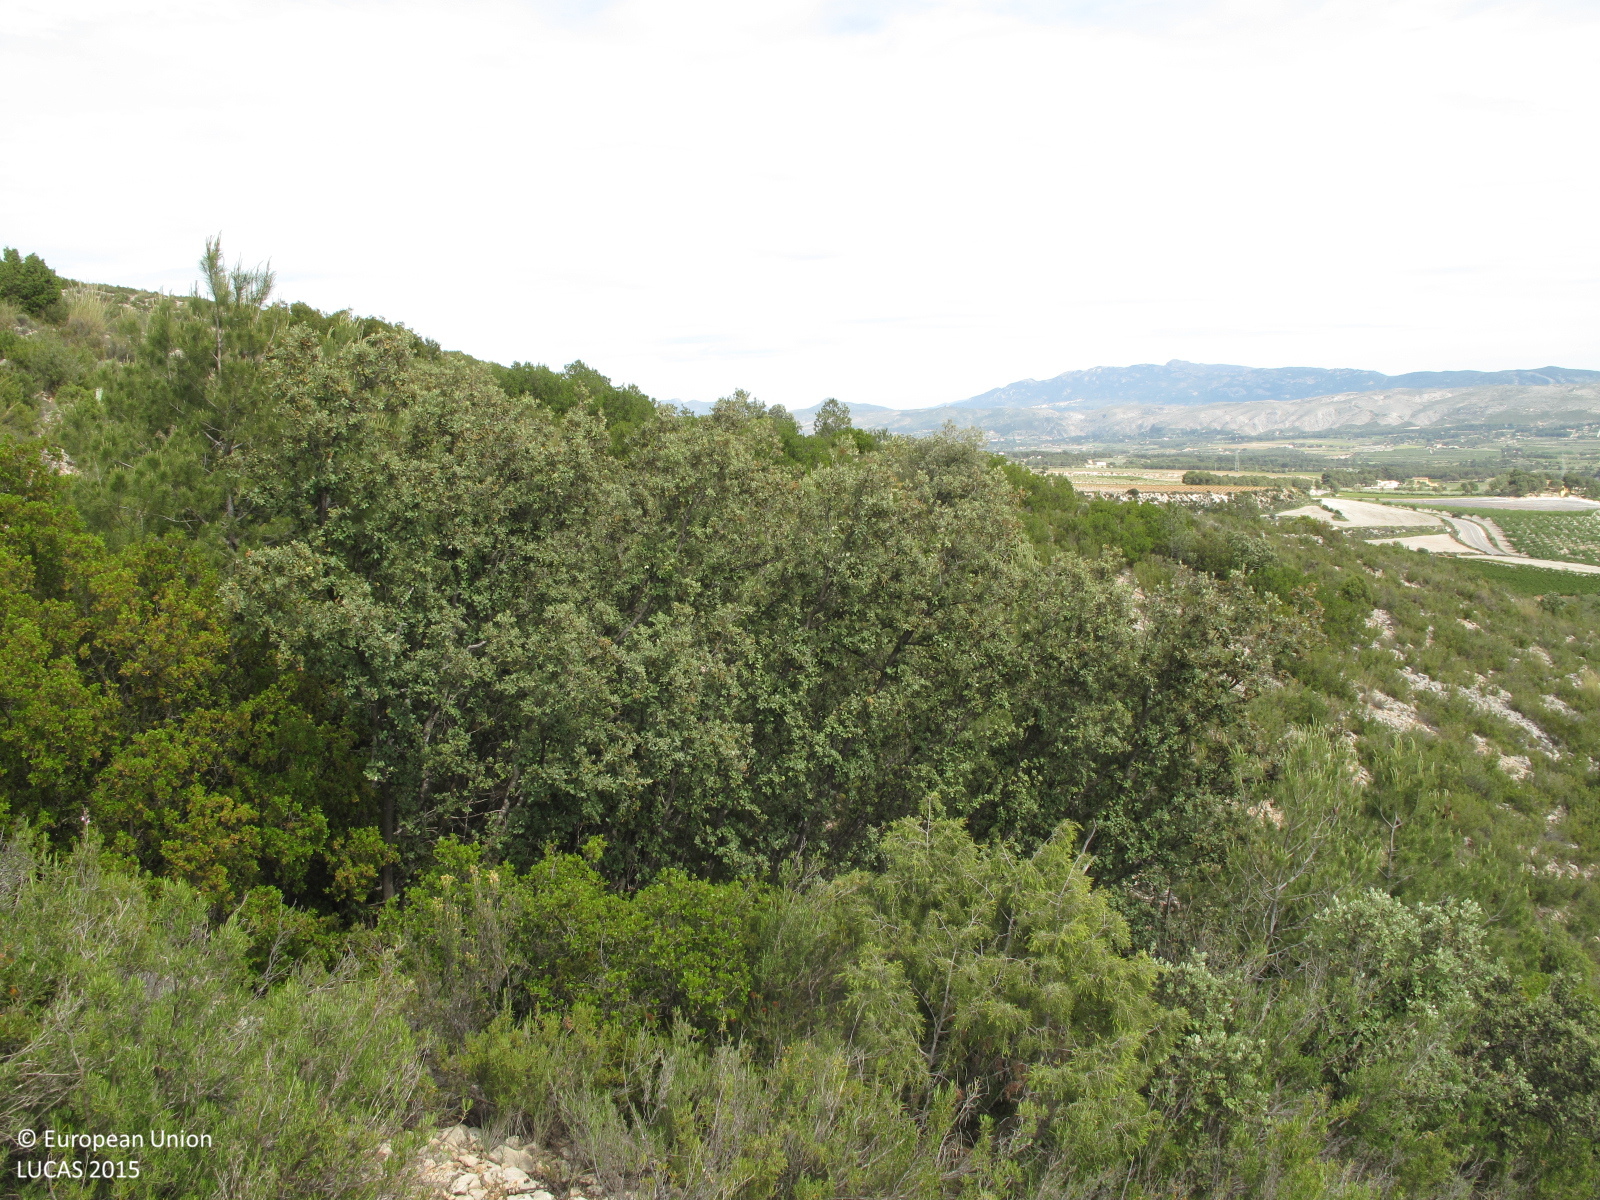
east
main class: Shrubland
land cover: Shrubland with sparse tree cover
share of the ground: 25 - 50 %
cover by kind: consolidated bare surface 50 %, shrubs 25 %, herbaceous plants 20 %, broadleaved forest trees 5 %
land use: Semi-natural and natural areas not in use
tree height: < 5 m
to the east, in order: Shrubland with sparse tree cover; Shrubland without tree cover
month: May
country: ES
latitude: 38.8212
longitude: -0.7147
